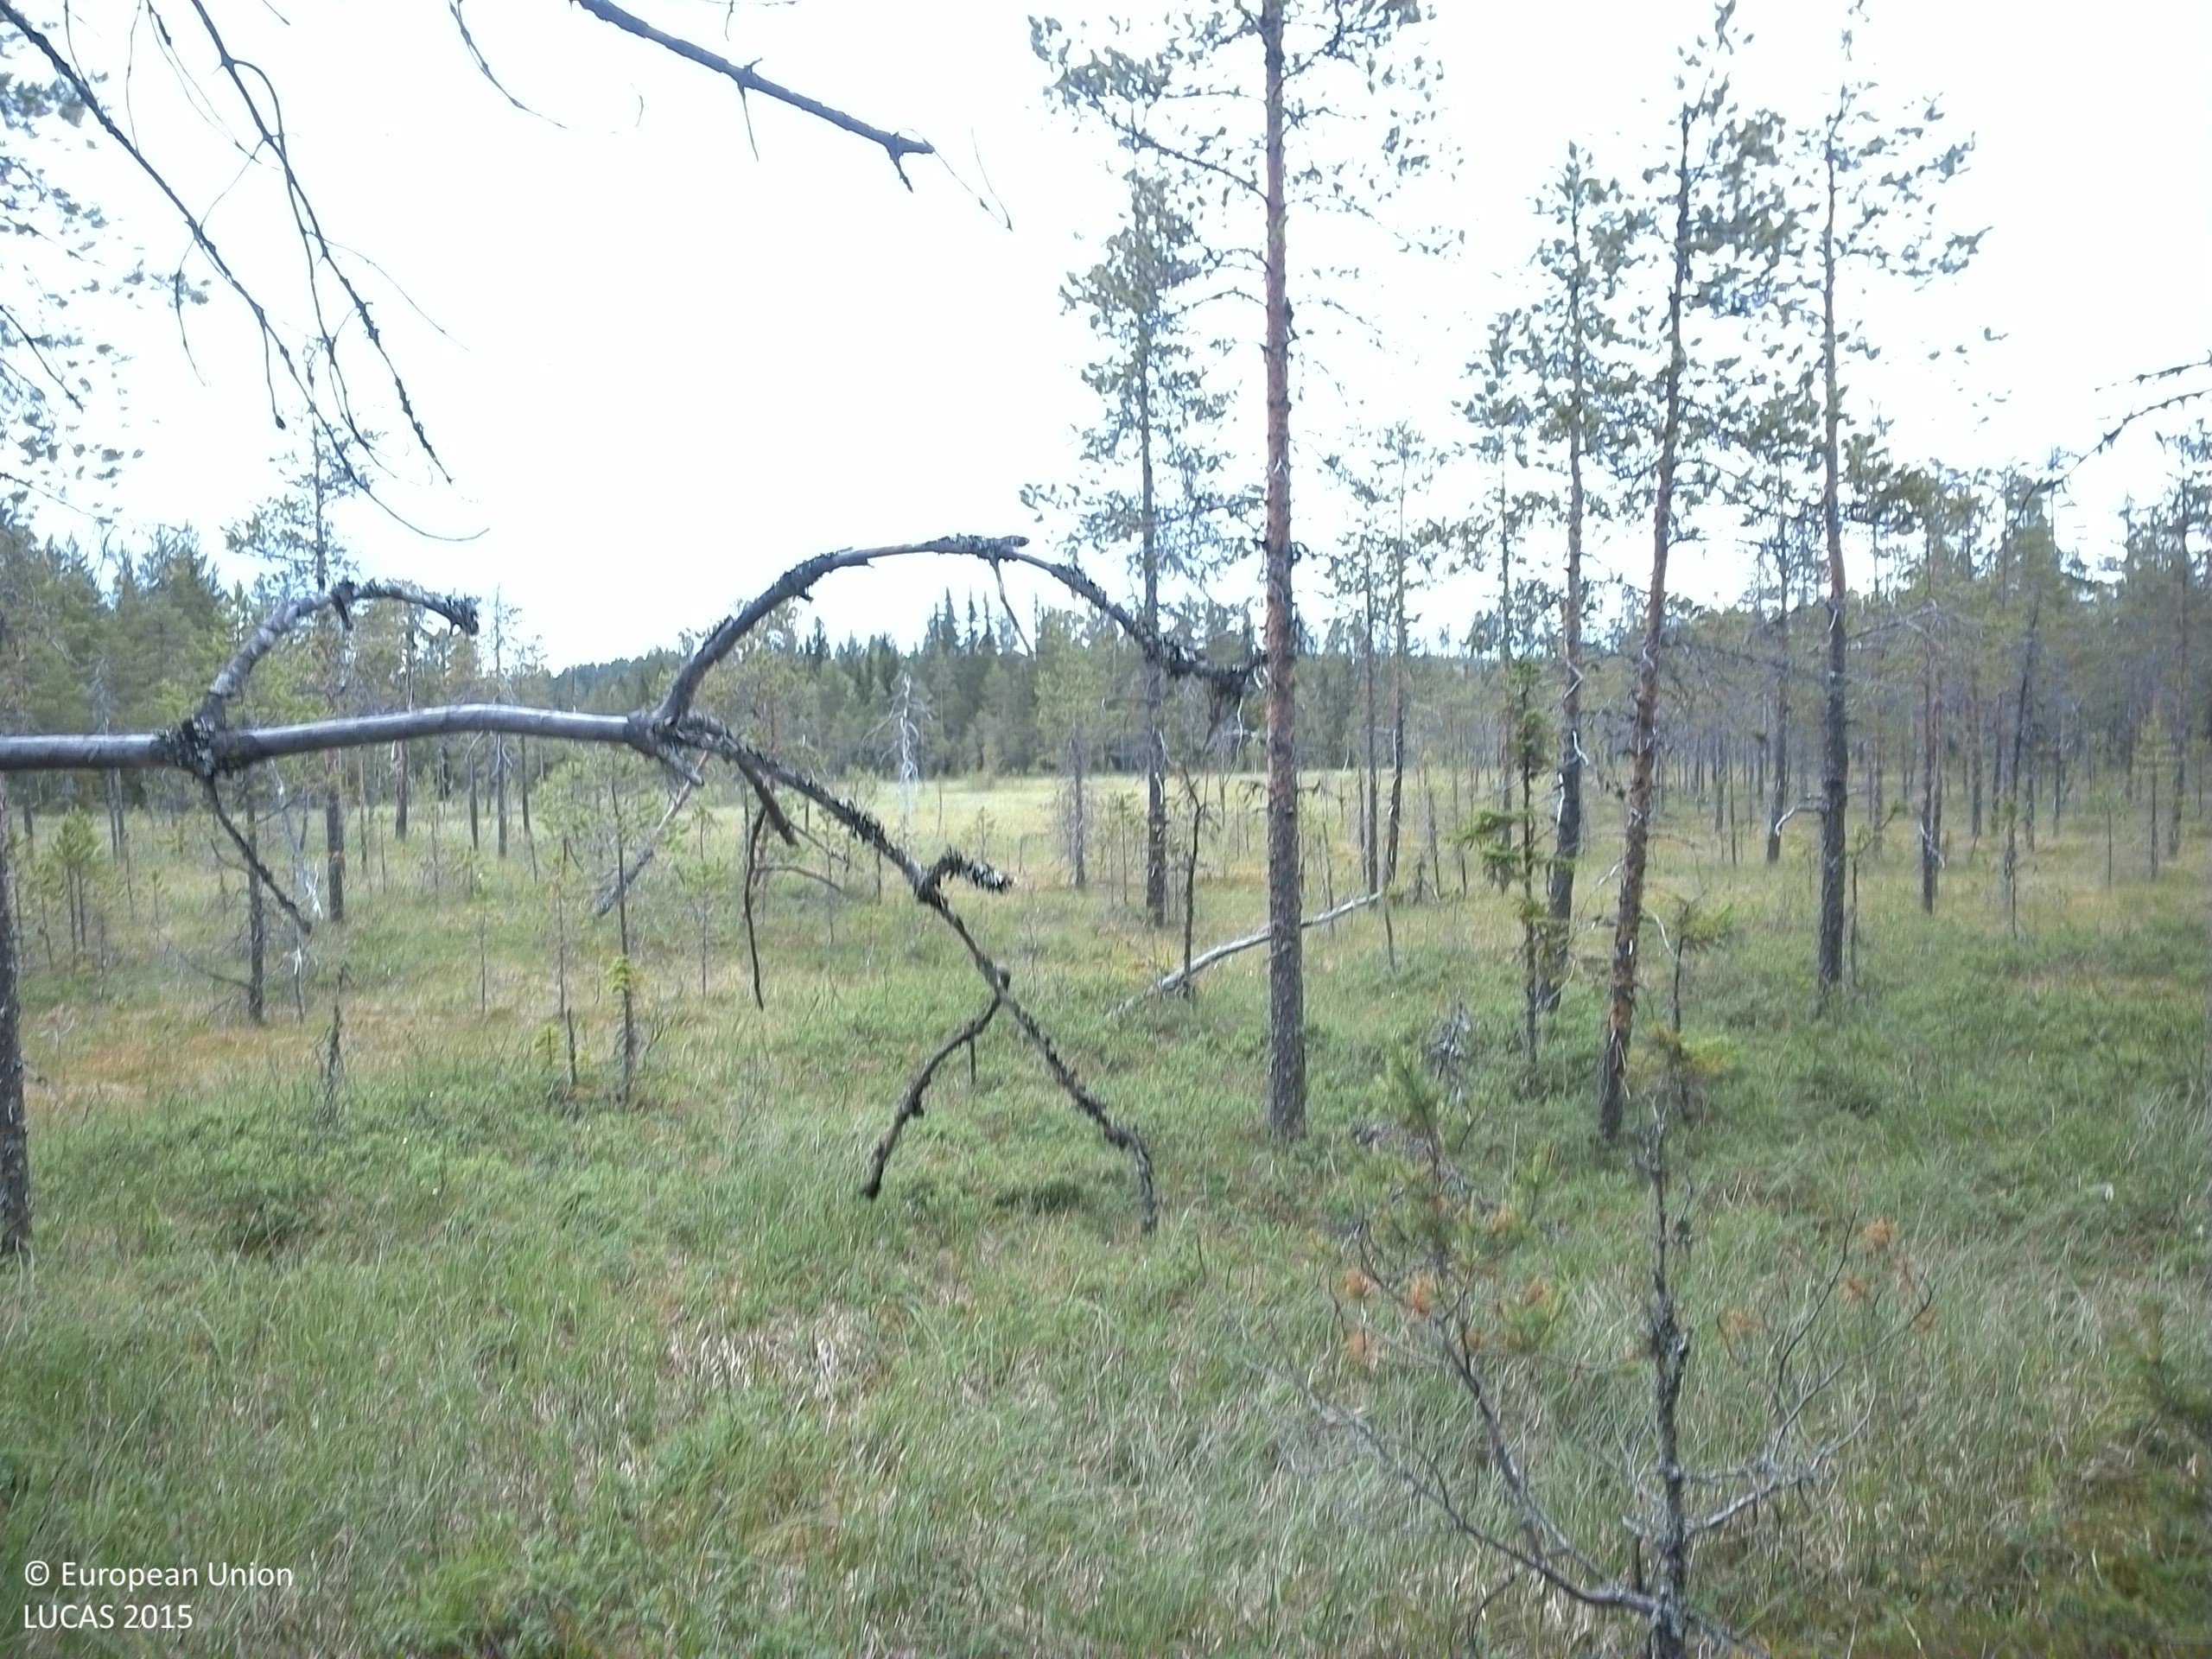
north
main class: Woodland
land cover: Pine dominated coniferous woodland
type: boreal forest
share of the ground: 25 - 50 %
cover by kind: shrubs 50 %, coniferous forest trees 35 %, lichens and mosses 10 %, broadleaved forest trees 5 %
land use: Forestry
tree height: > 5 m
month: July
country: SE
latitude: 63.6080
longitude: 17.4137
